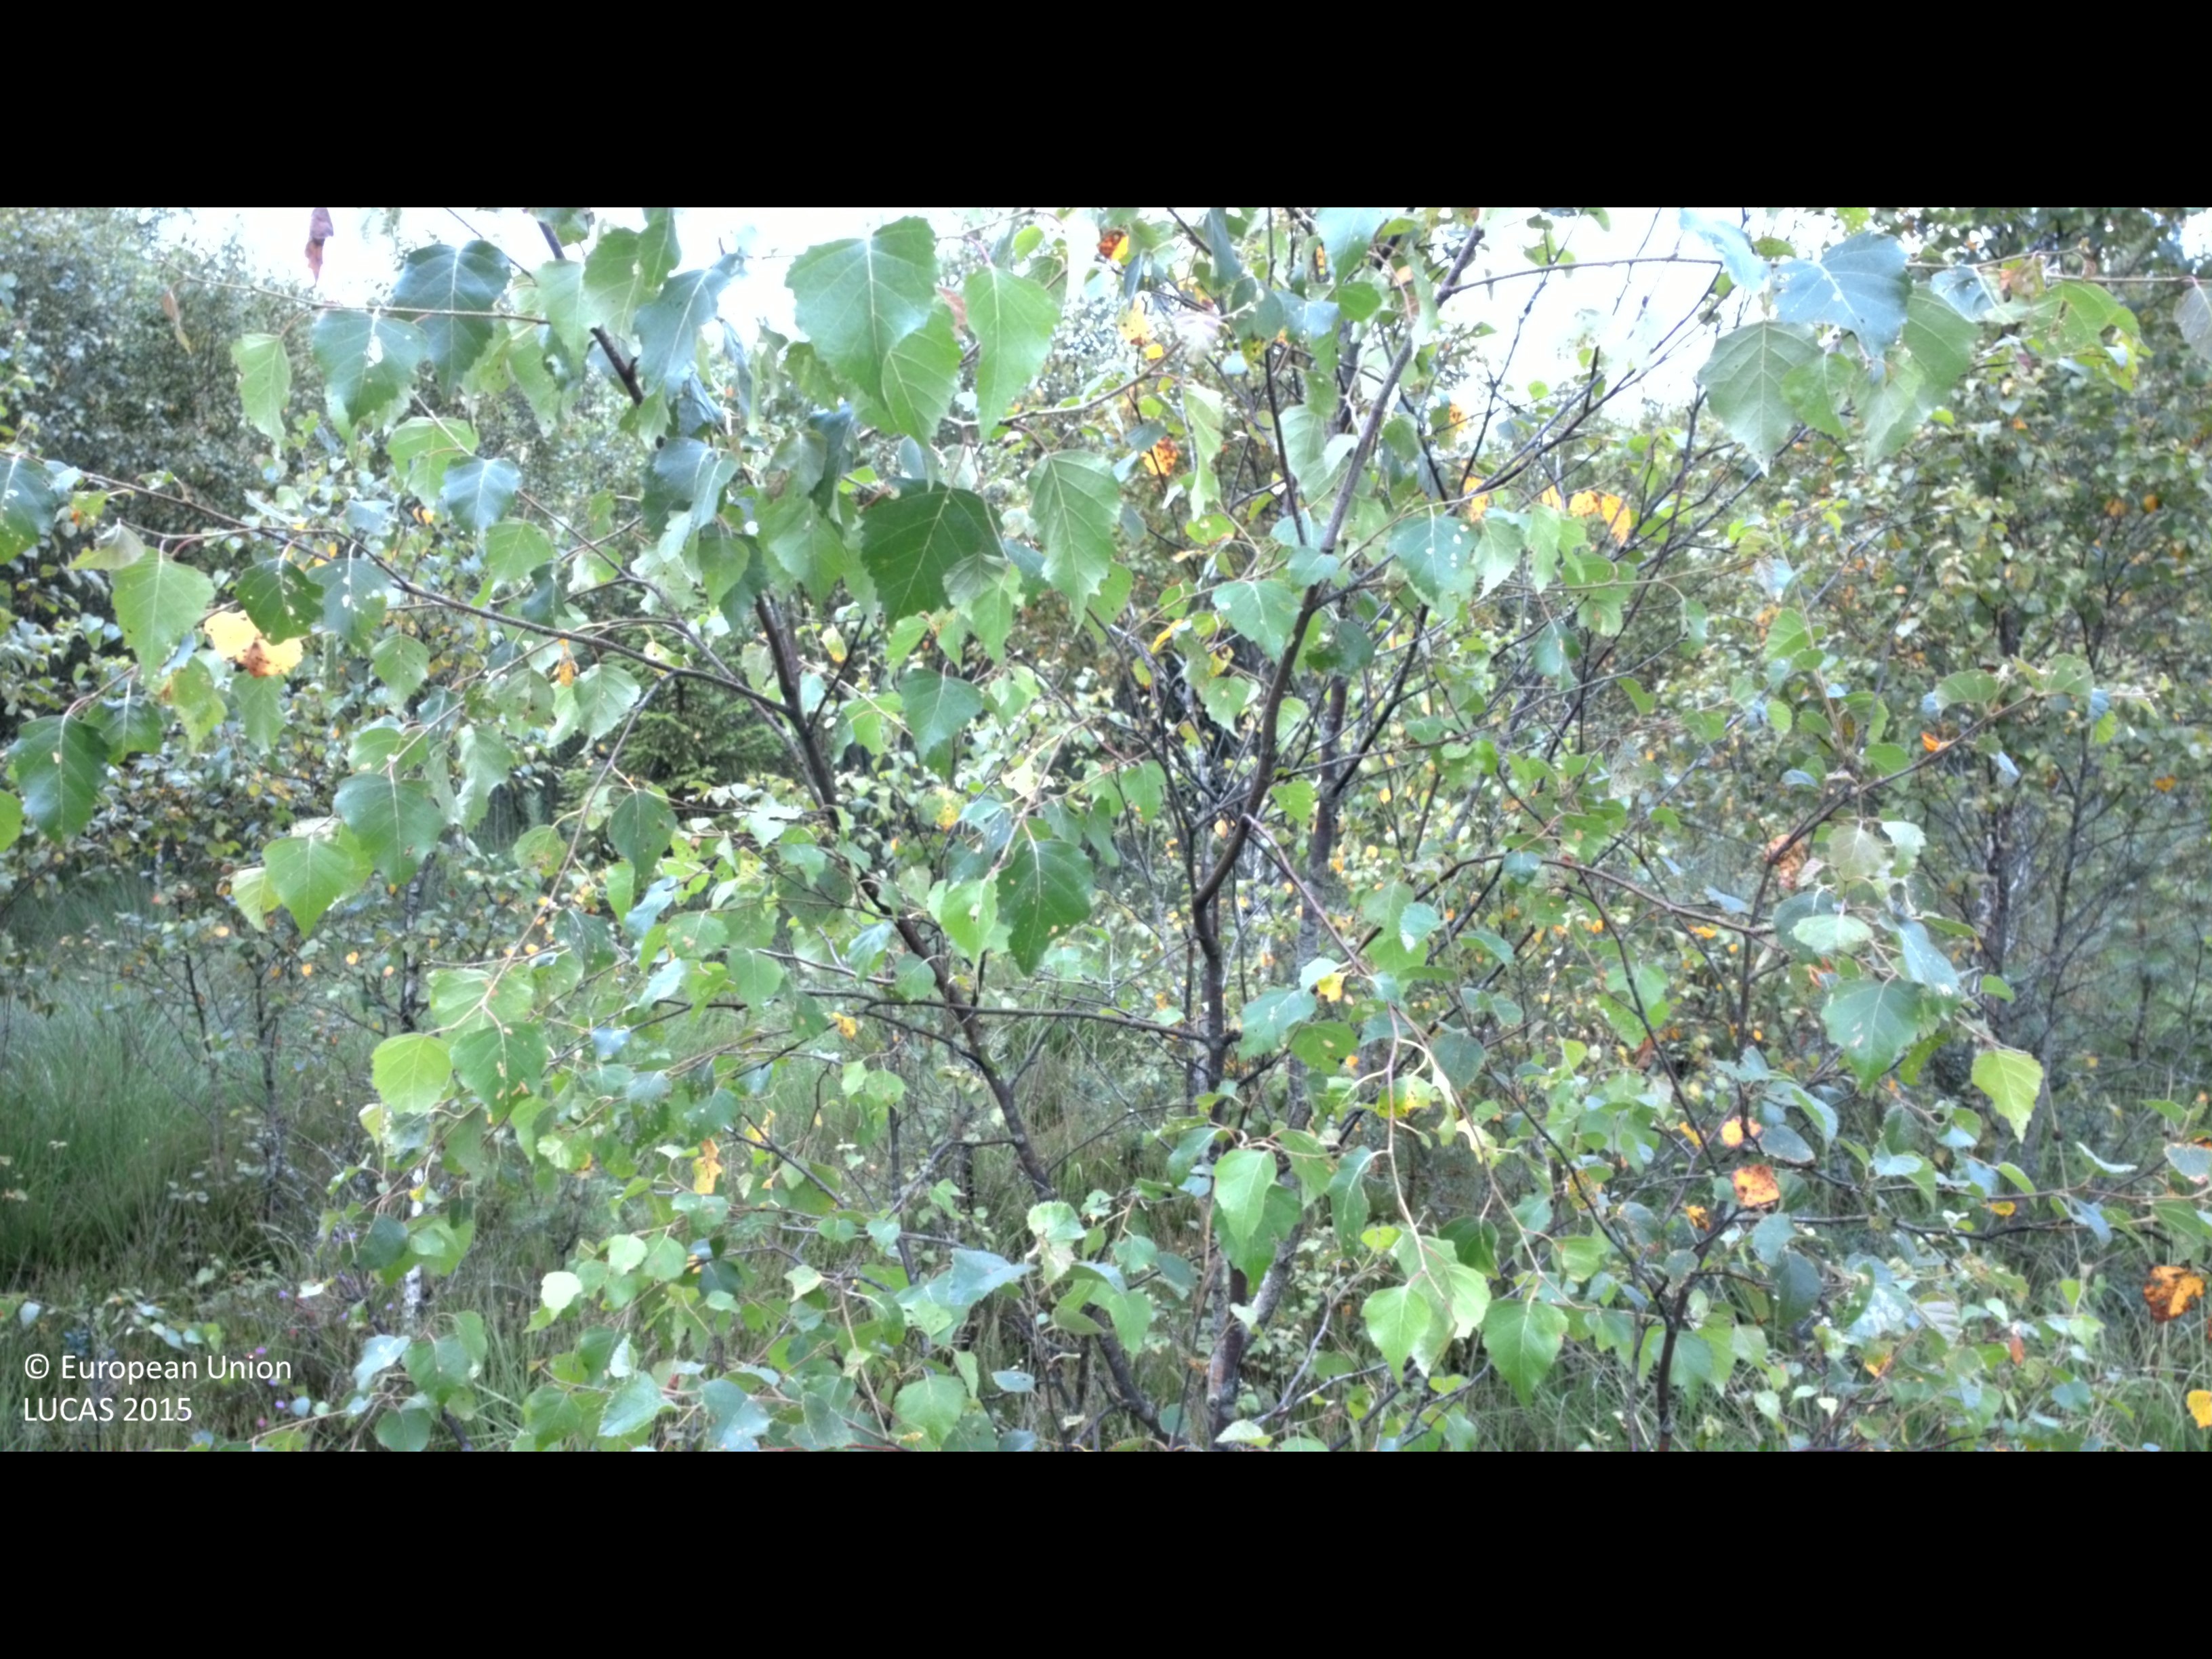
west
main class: Woodland
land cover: Spruce dominated mixed woodland
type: boreal forest
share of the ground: 50 - 75 %
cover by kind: broadleaved forest trees 45 %, herbaceous plants 35 %, coniferous forest trees 15 %, shrubs 5 %
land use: Forestry
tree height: < 5 m
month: August
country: SE
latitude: 56.7424
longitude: 13.8389
